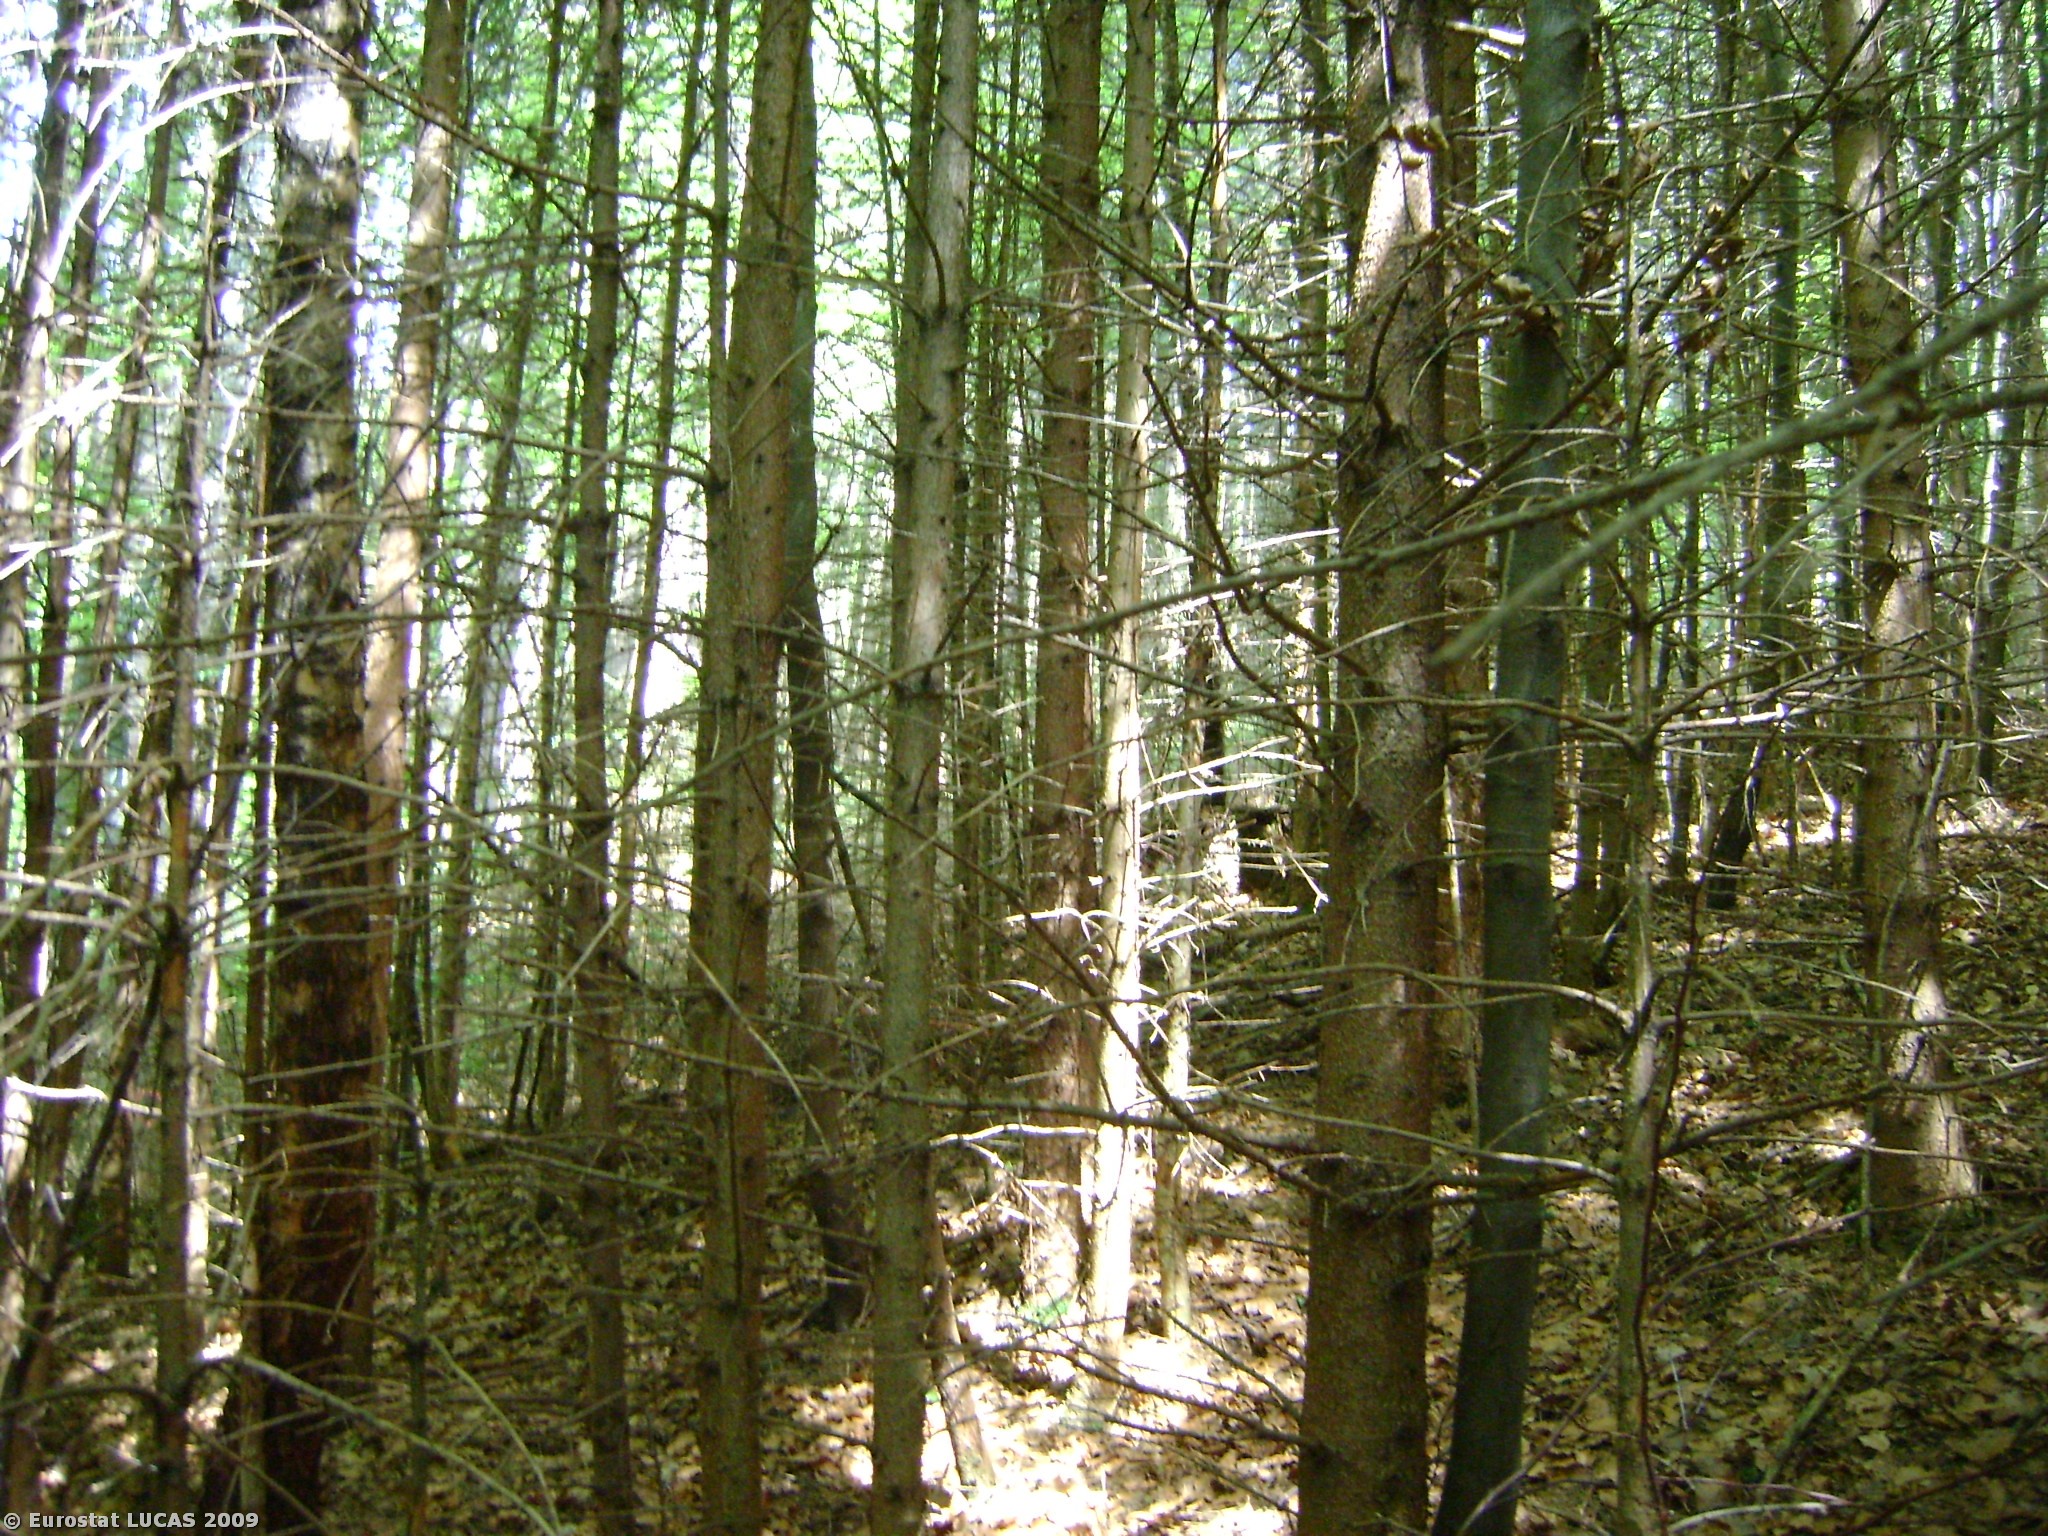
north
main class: Woodland
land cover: Coniferous woodland
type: boreal forest
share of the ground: > 75 %
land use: Forestry
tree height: > 5 m
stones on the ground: < 10 %
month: May
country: AT
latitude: 47.9235
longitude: 13.2509
